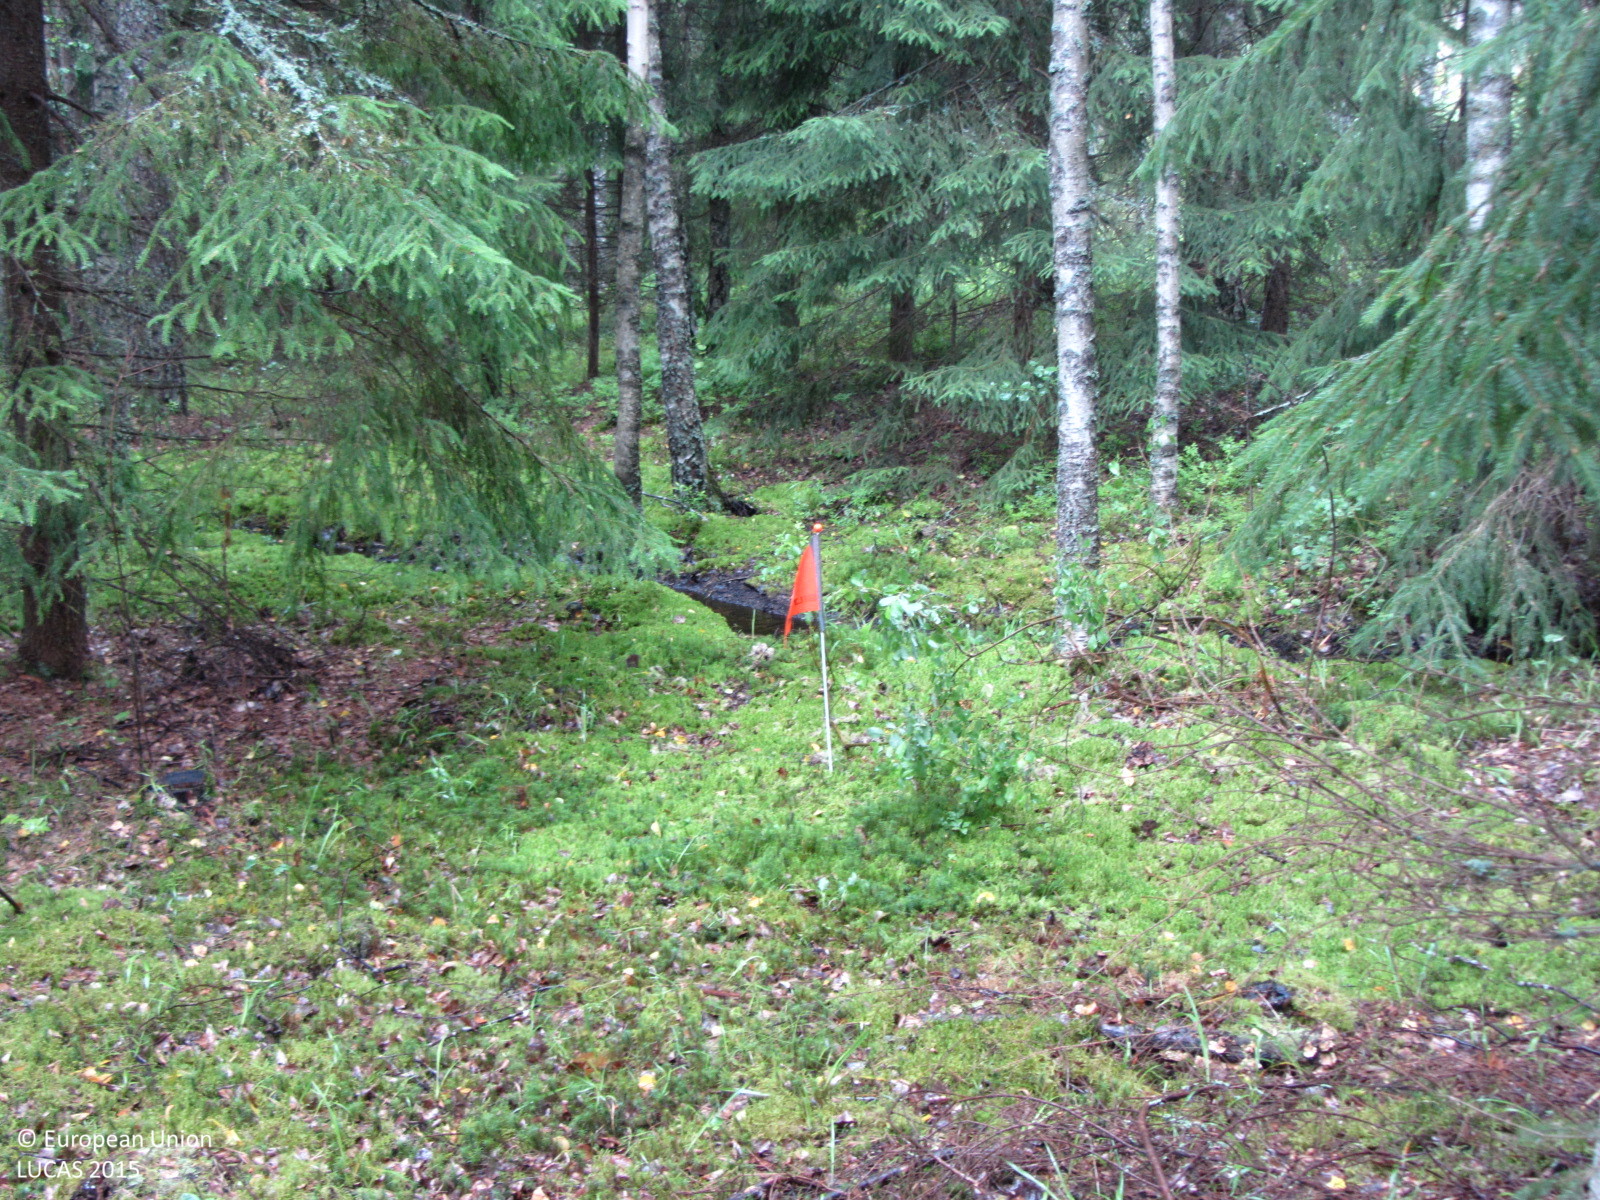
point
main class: Woodland
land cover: Spruce dominated mixed woodland
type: boreal forest
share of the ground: > 75 %
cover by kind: coniferous forest trees 60 %, broadleaved forest trees 25 %, lichens and mosses 10 %, herbaceous plants 5 %
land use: Forestry
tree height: > 5 m
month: July
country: FI
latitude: 59.9679
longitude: 23.1059
